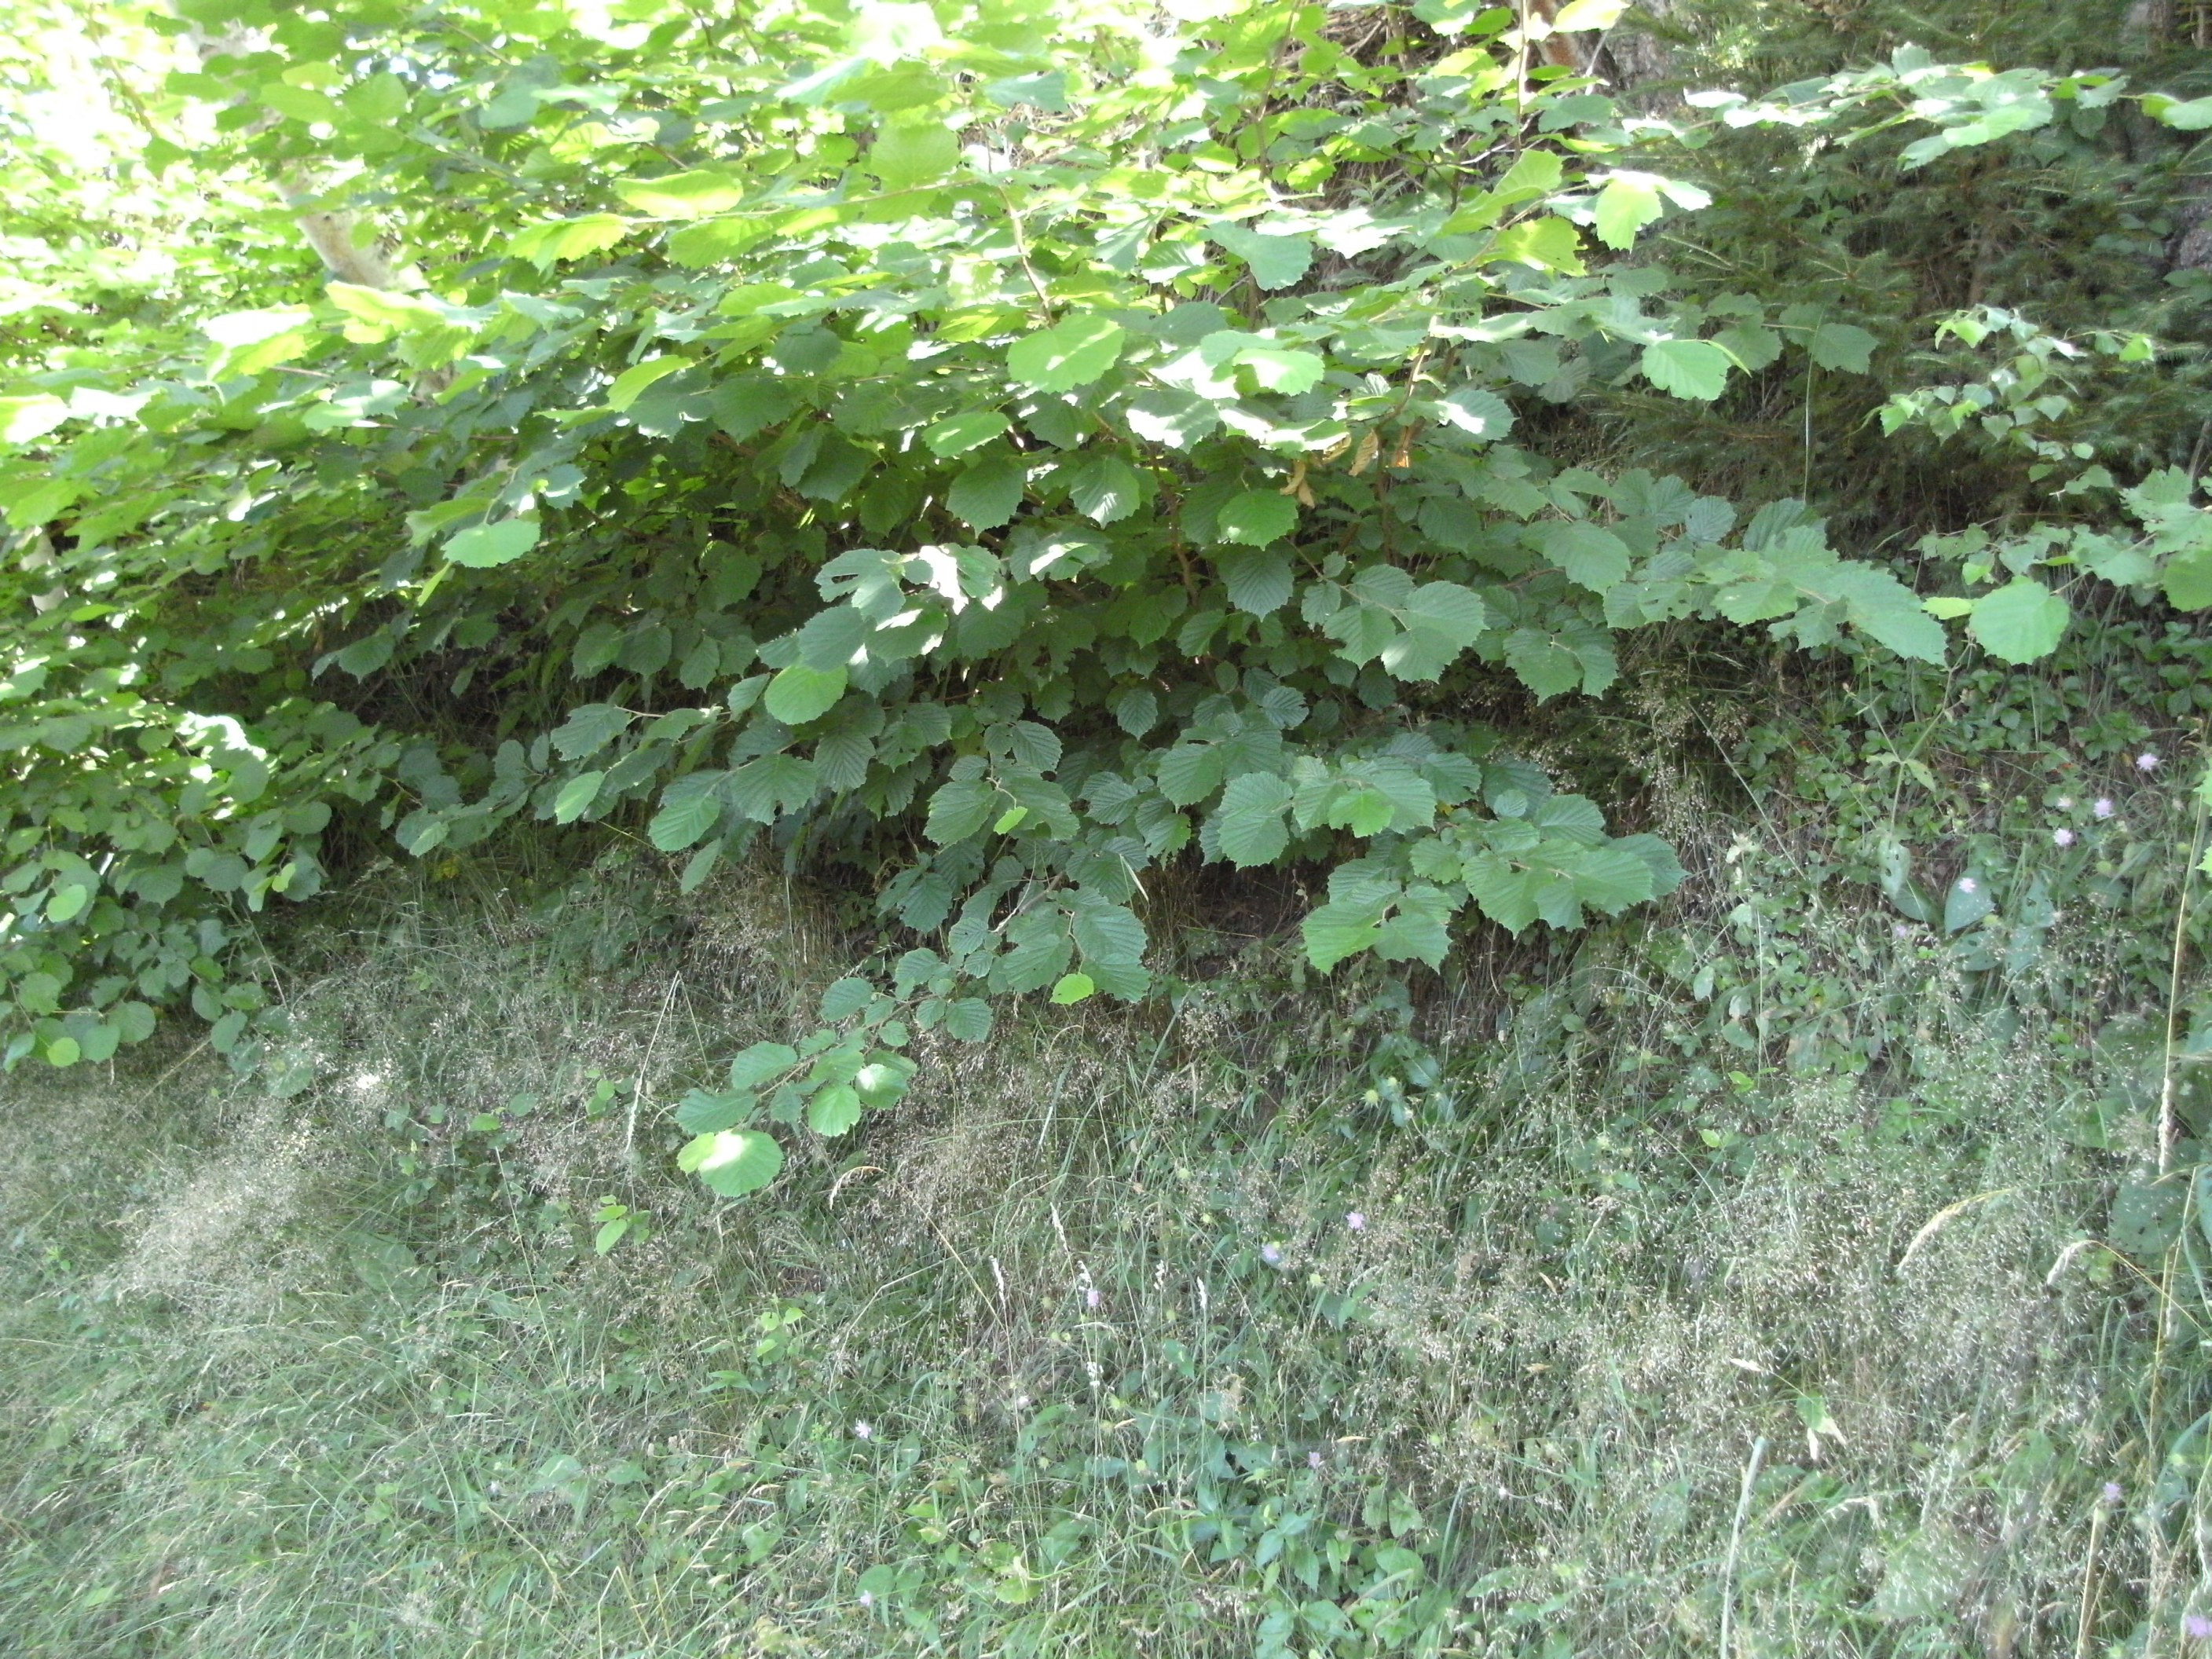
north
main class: Grassland
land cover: Grassland without tree/shrub cover
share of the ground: > 75 %
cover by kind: herbaceous plants 100 %
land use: Agriculture (excluding fallow land and kitchen gardens)
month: July
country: AT
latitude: 46.8157
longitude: 14.9133
